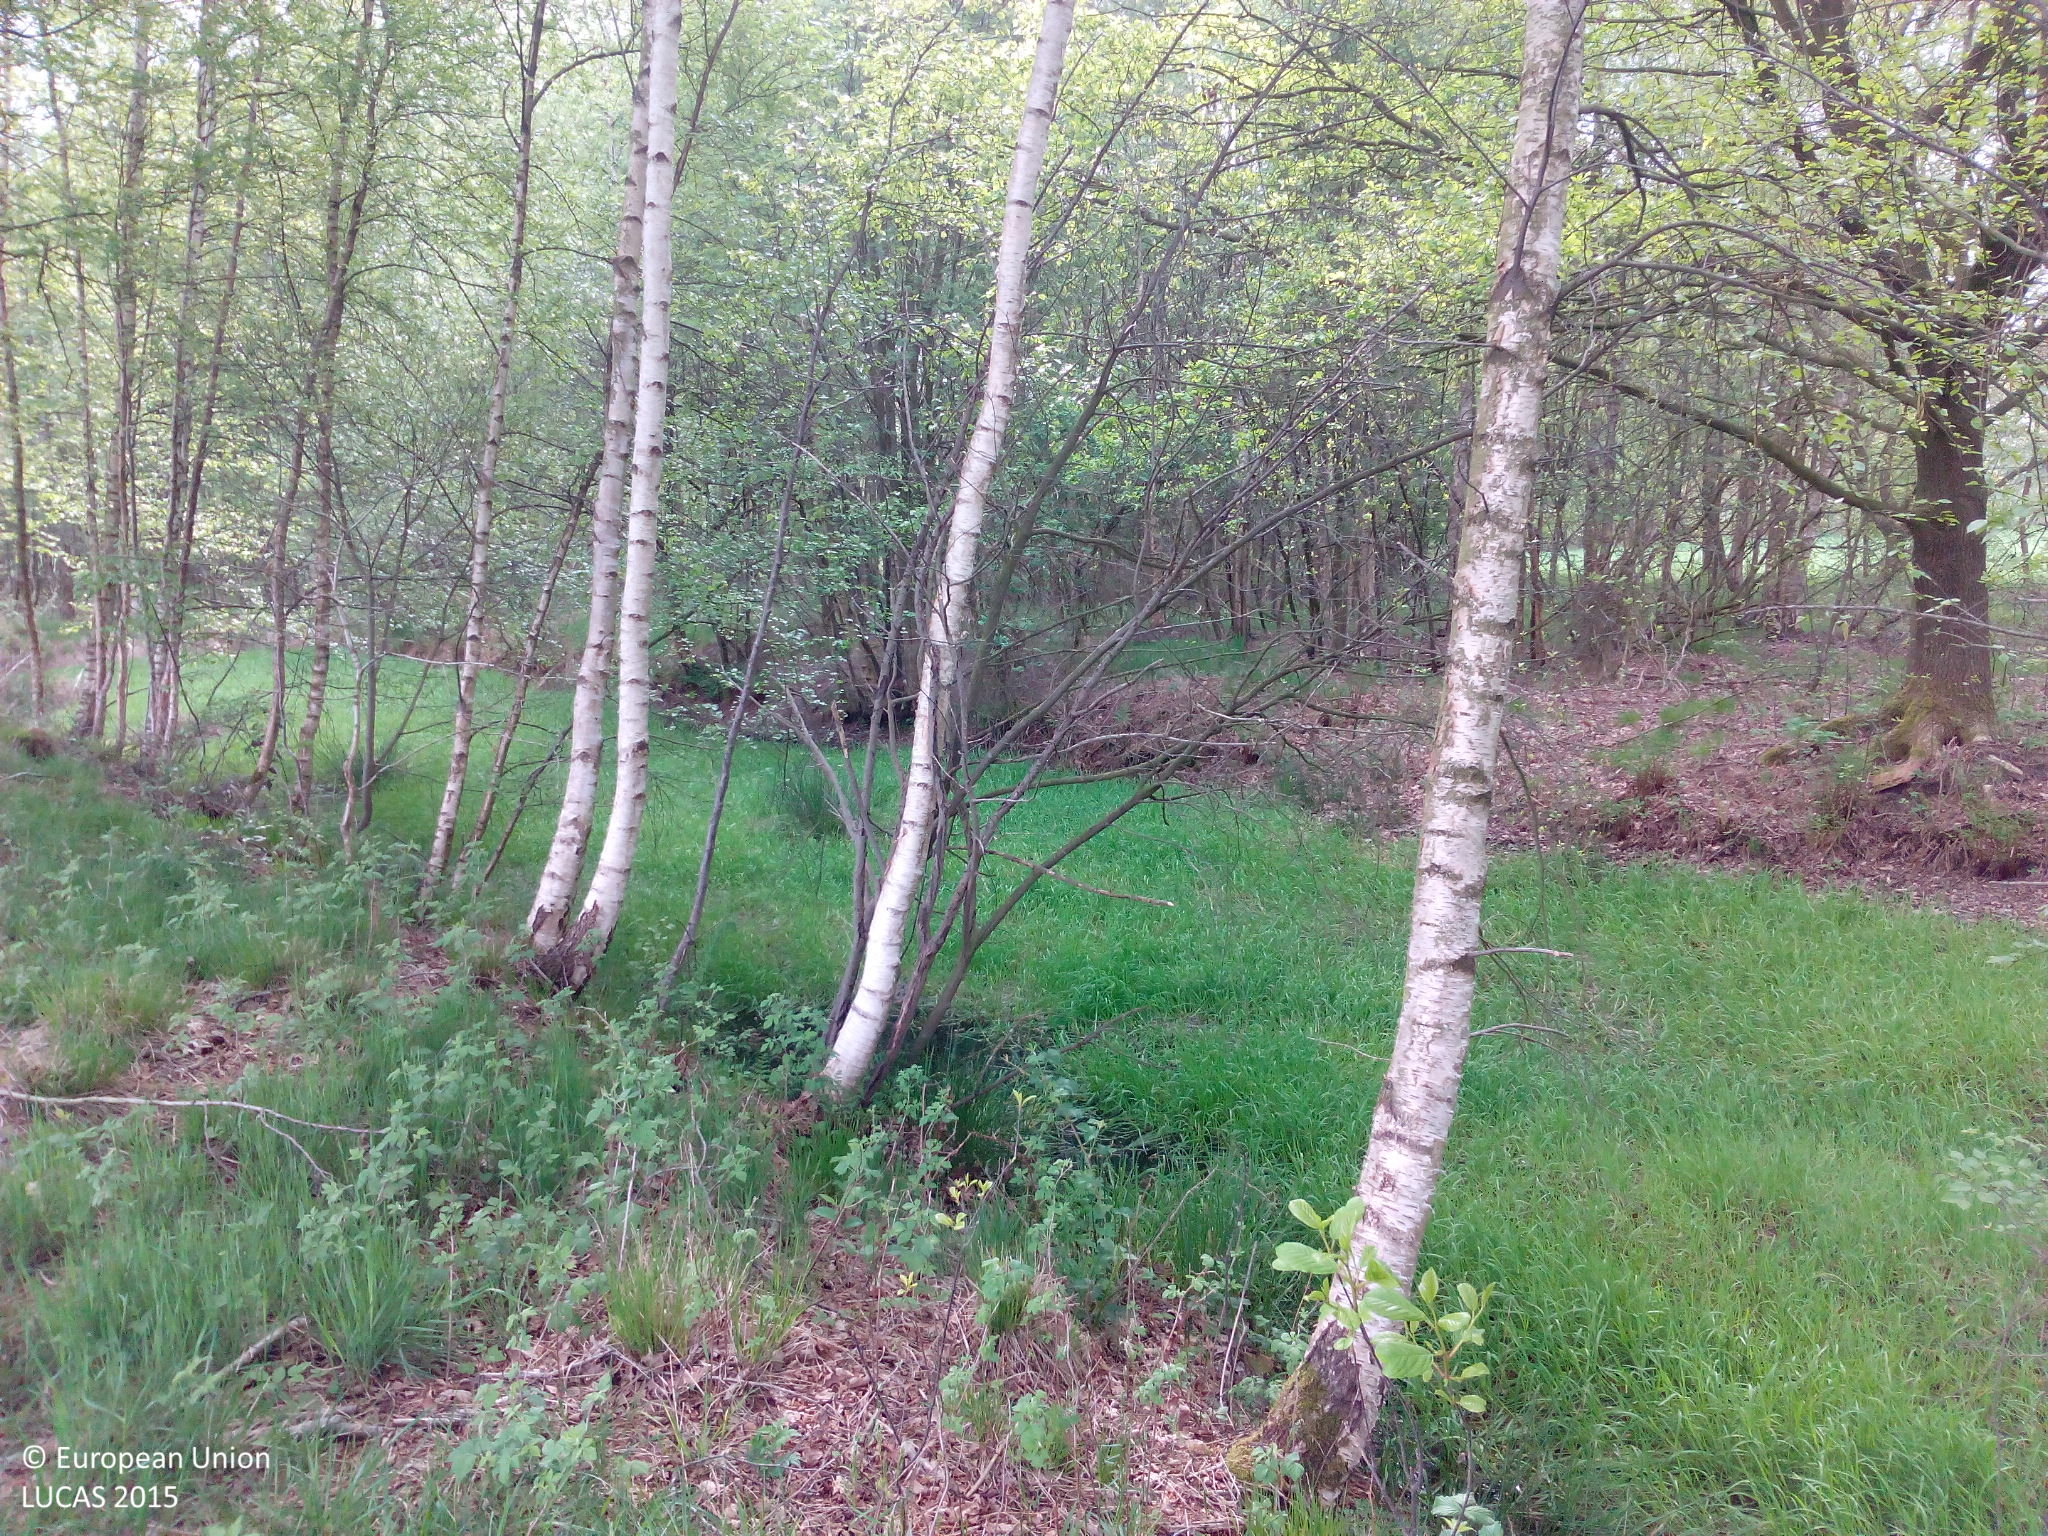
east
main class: Woodland
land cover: Broadleaved woodland
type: mire and swamp forests
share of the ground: > 75 %
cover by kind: broadleaved forest trees 70 %, coniferous forest trees 10 %, shrubs 10 %, herbaceous plants 10 %
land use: Semi-natural and natural areas not in use
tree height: > 5 m
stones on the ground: < 10 %
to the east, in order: Broadleaved woodland; Inland marshes; Broadleaved woodland; Tracks; Lines of trees; Ditches and canals; Grassland without tree/shrub cover; Lines of trees; Temporary grasslands
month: May
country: DE
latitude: 53.2376
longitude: 9.2063
